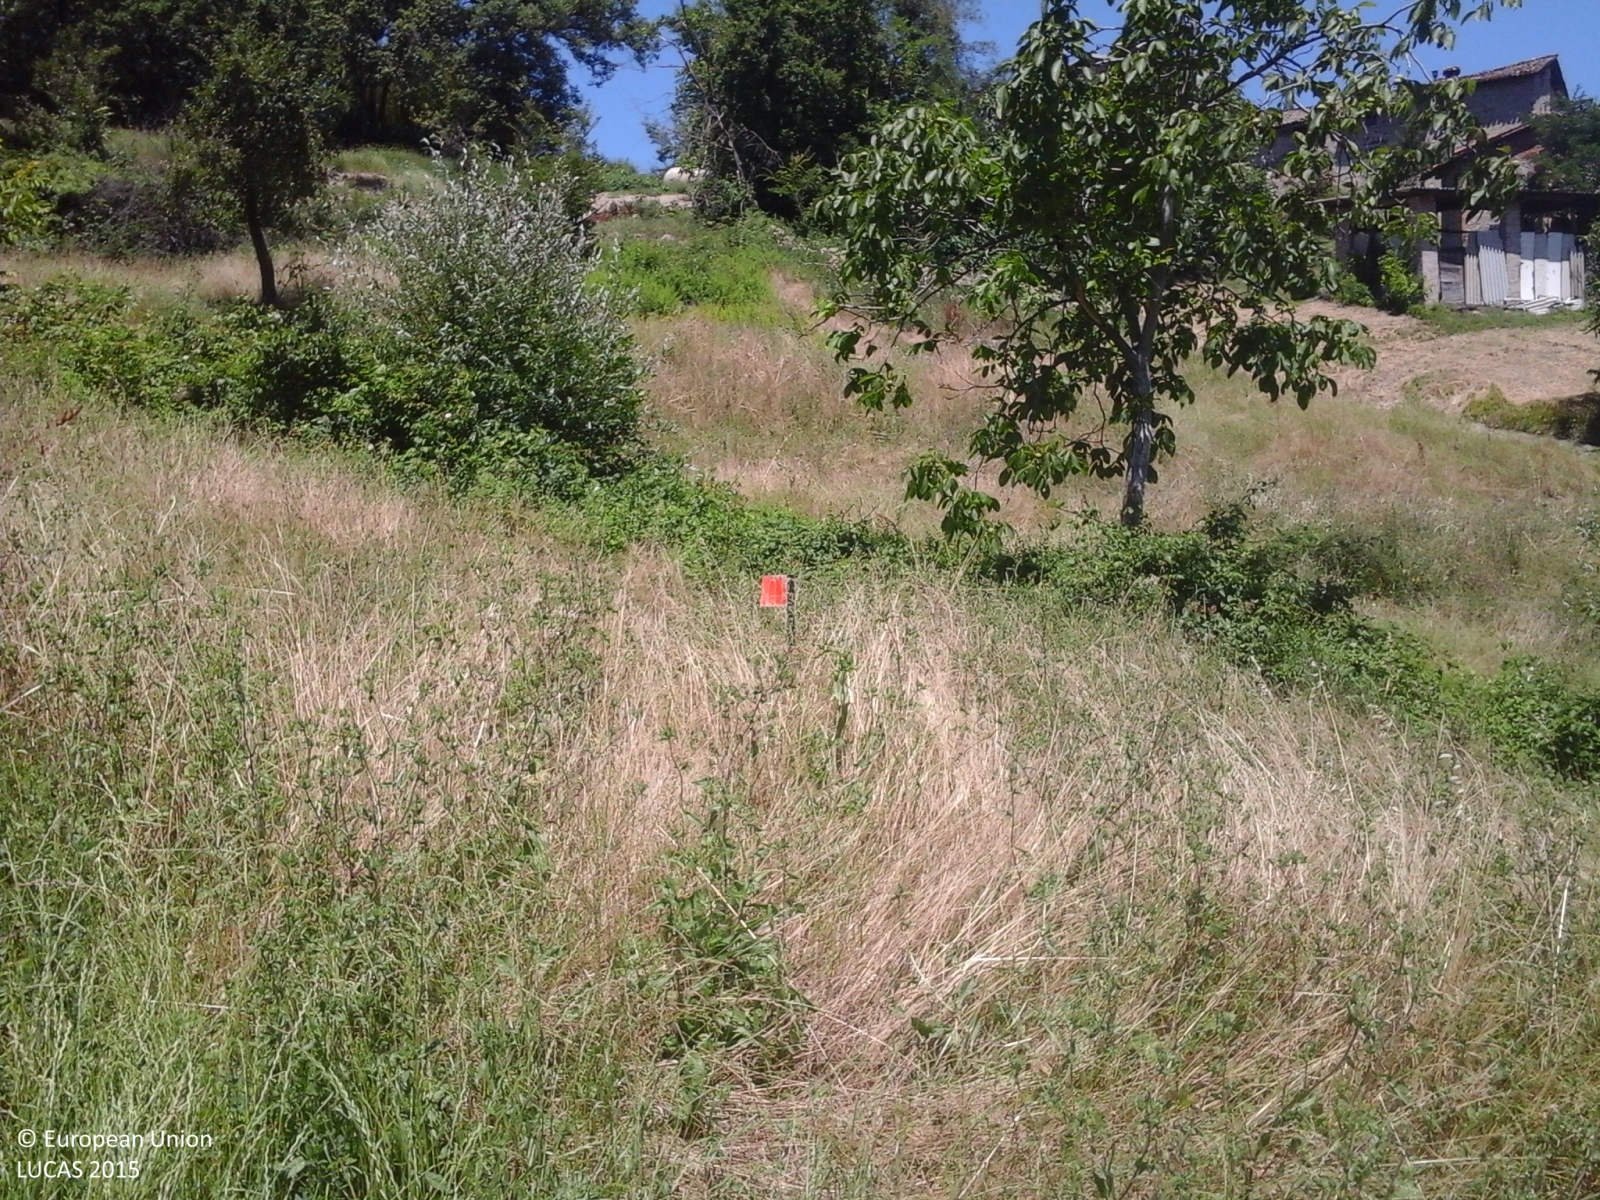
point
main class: Grassland
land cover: Grassland without tree/shrub cover
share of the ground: > 75 %
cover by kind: herbaceous plants 100 %
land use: Agriculture (excluding fallow land and kitchen gardens)
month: June
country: IT
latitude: 44.5288
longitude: 10.6654
